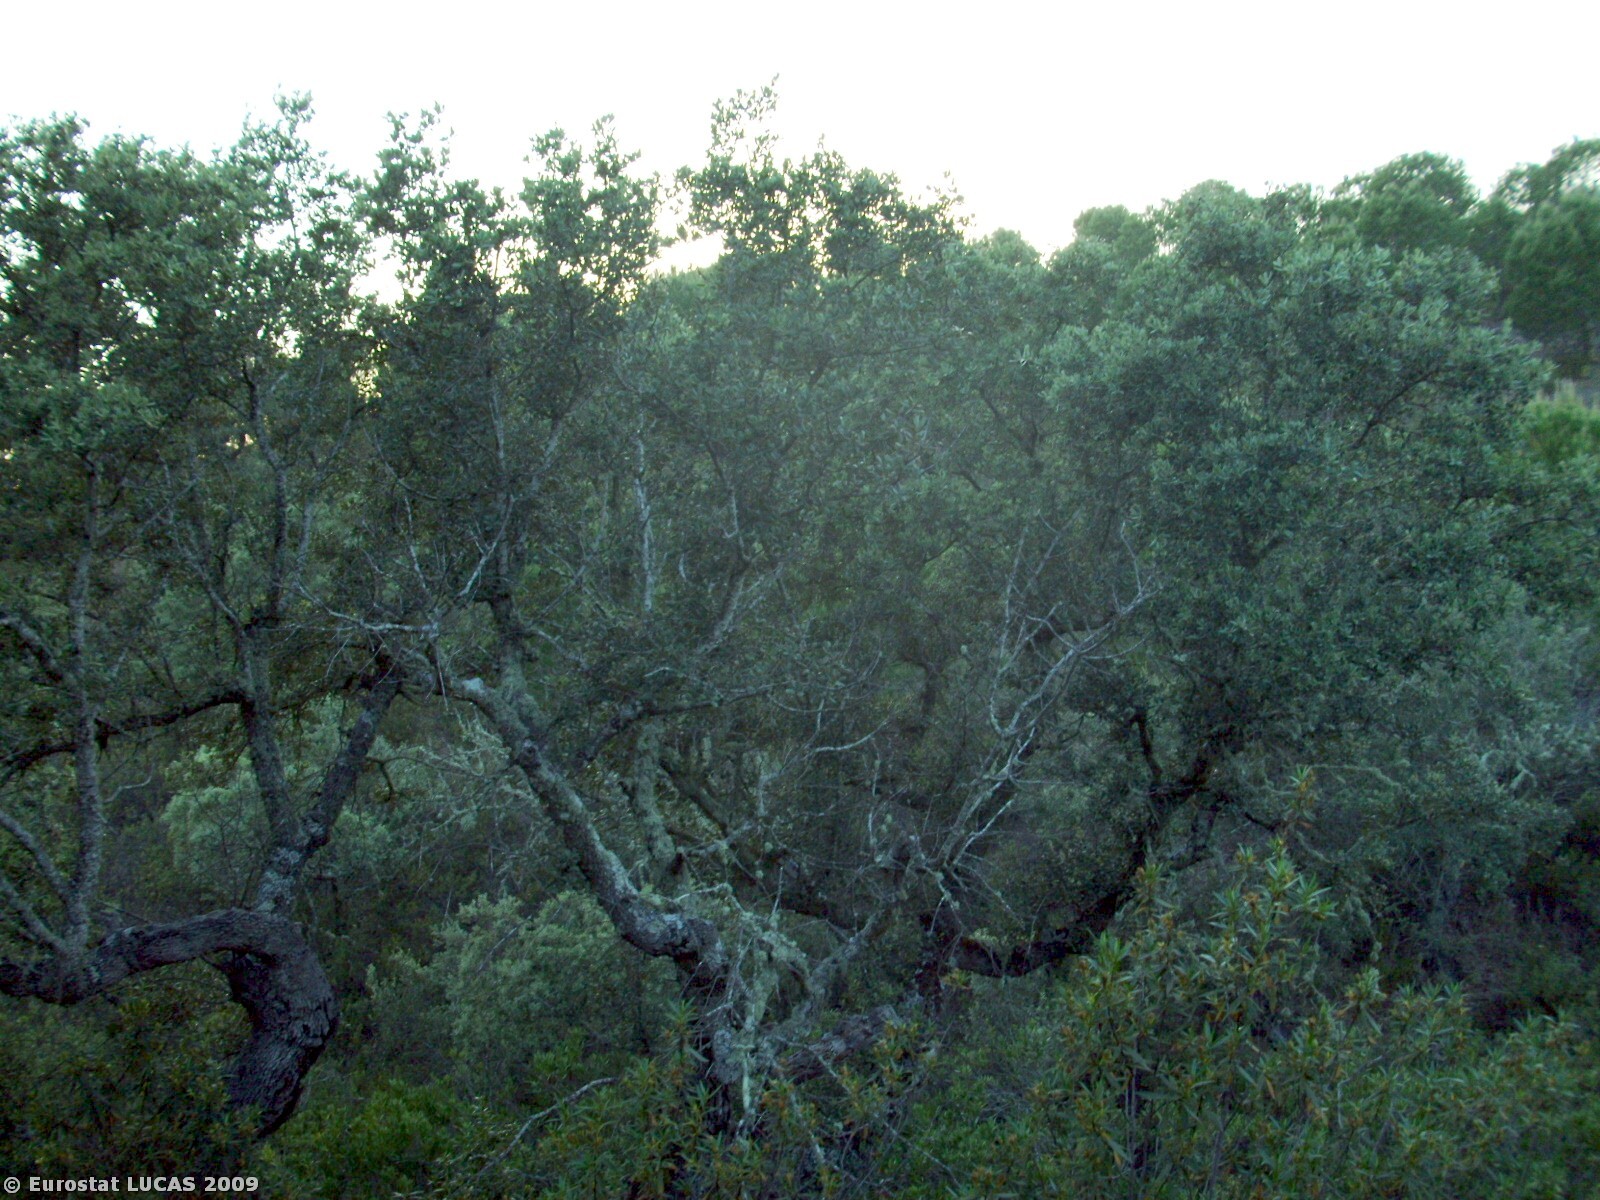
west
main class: Woodland
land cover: Coniferous woodland
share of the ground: 25 - 50 %
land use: Forestry
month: May
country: PT
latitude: 37.4729
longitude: -7.7325
